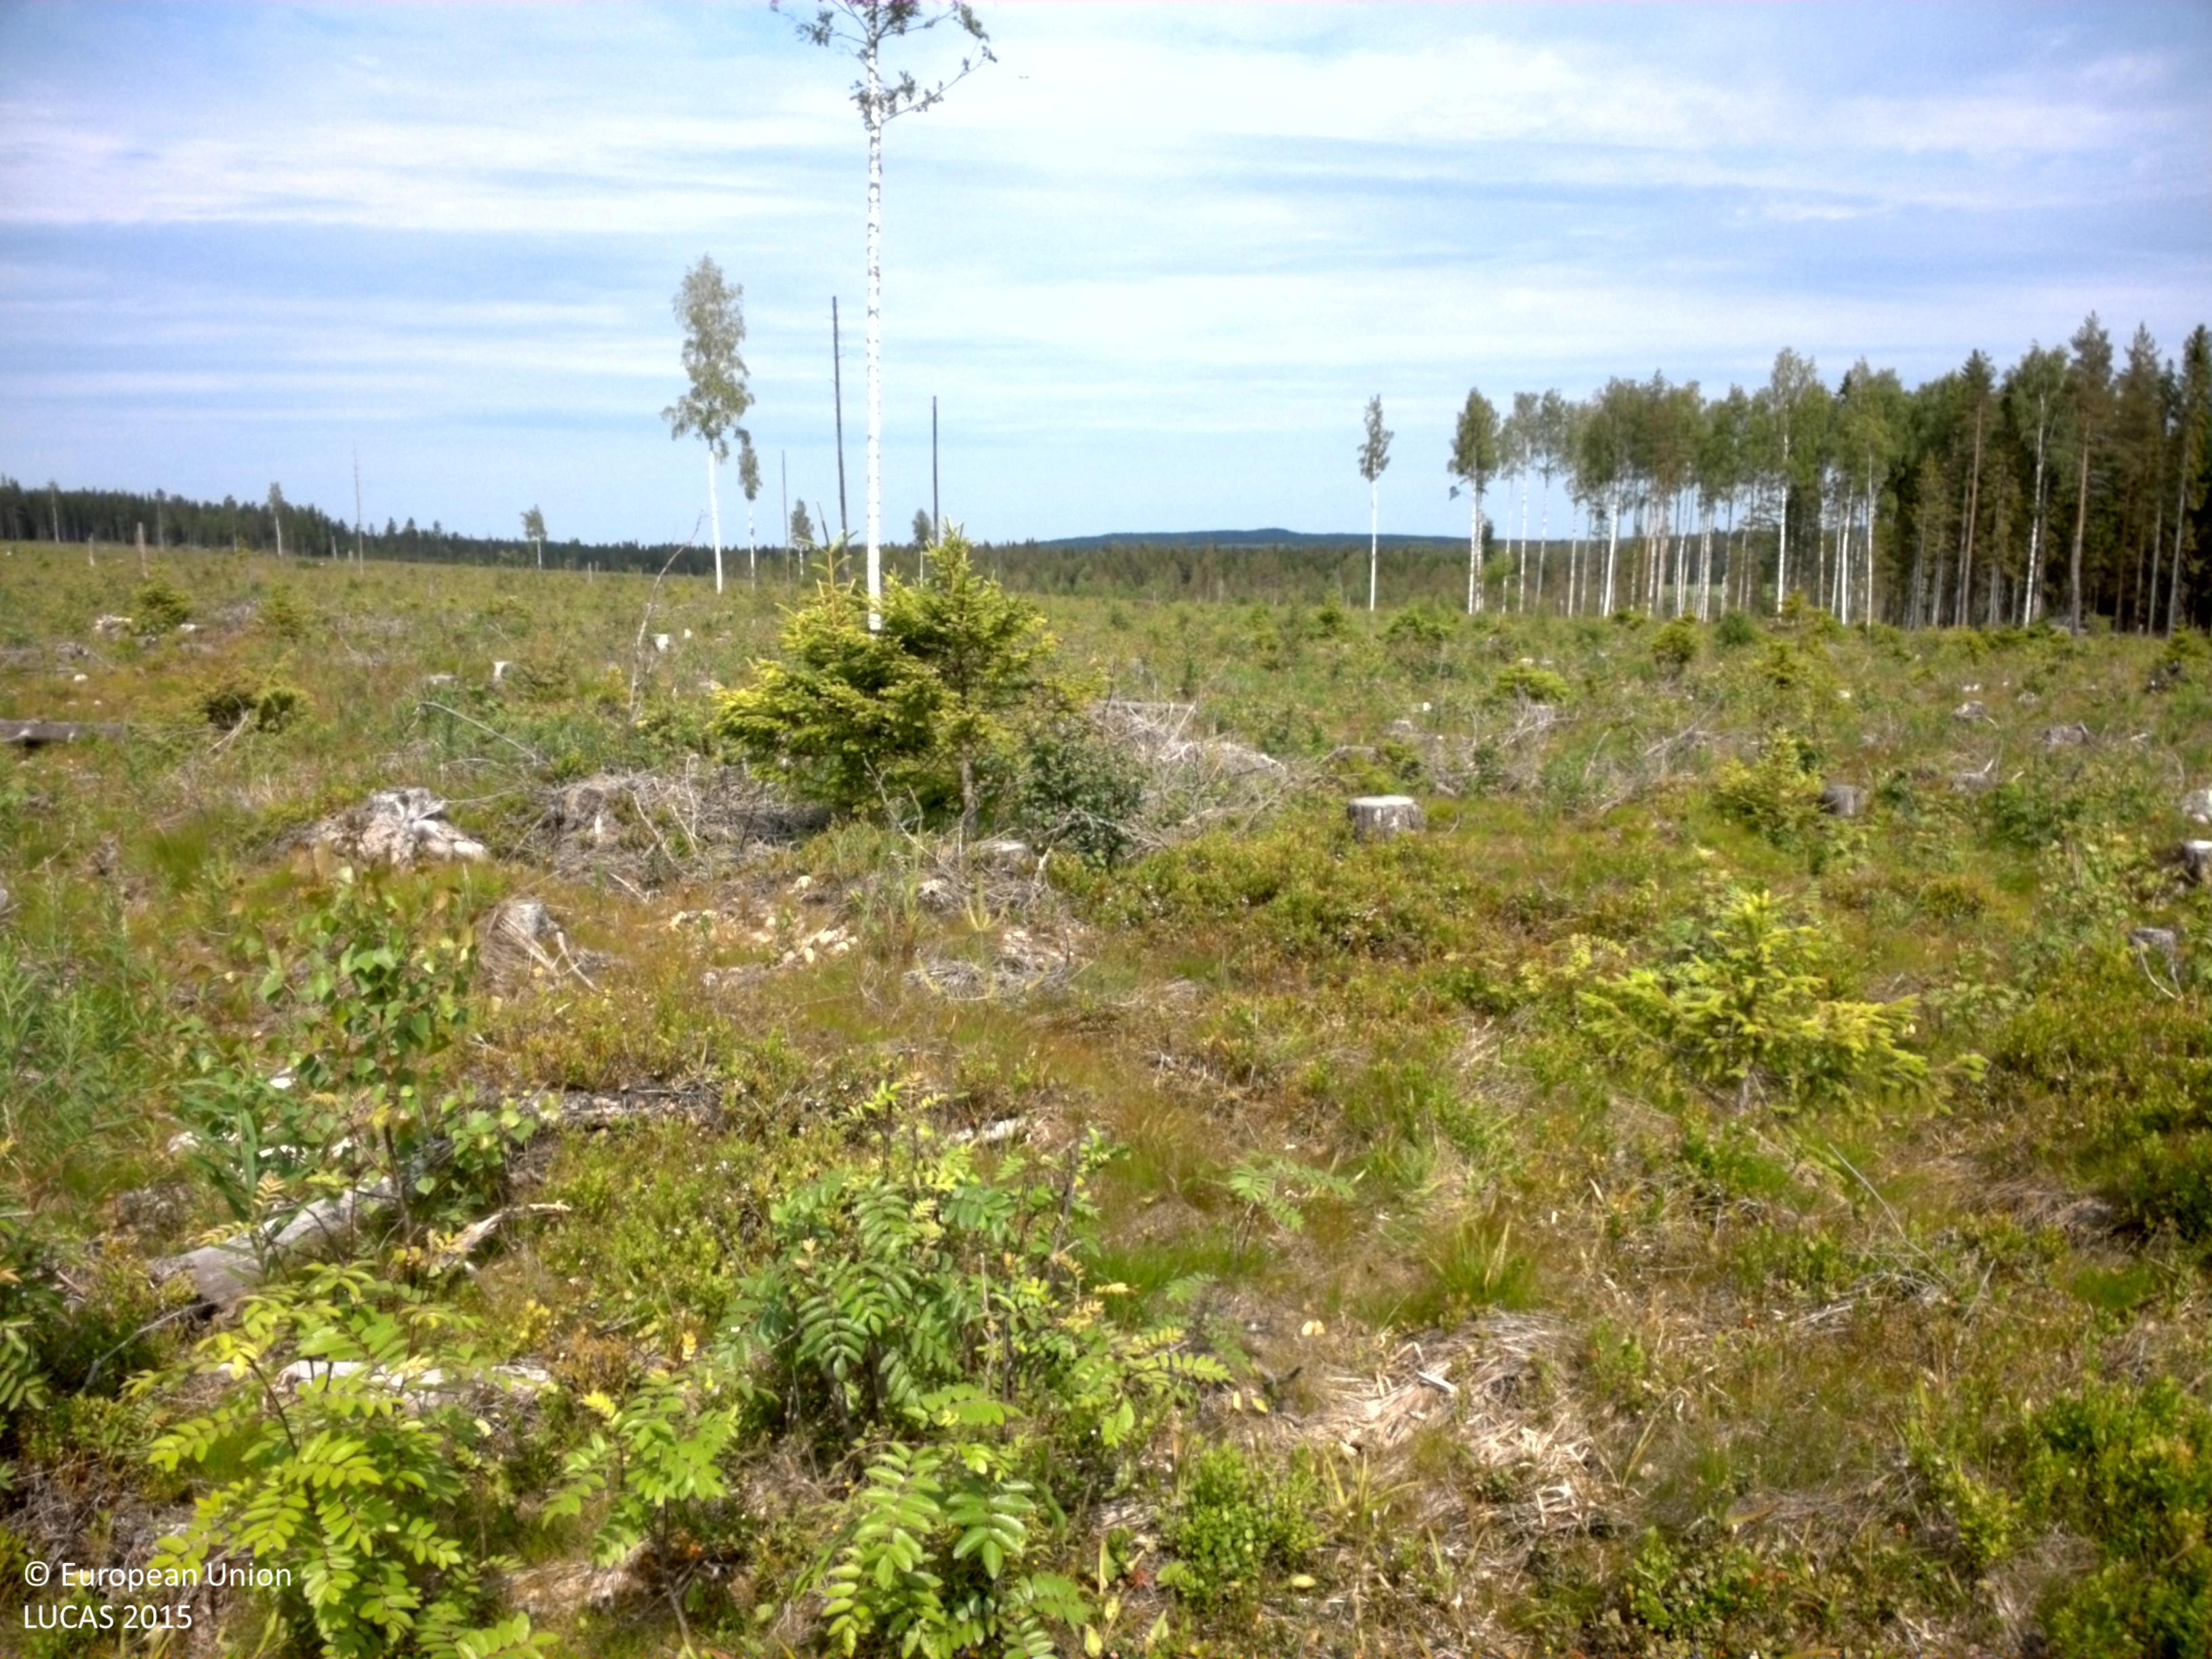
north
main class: Grassland
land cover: Grassland with sparse tree/shrub cover
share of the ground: > 75 %
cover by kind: herbaceous plants 75 %, shrubs 10 %, unconsolidated bare surface 10 %, broadleaved forest trees 5 %
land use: Forestry
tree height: > 5 m
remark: Clear cut
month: July
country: SE
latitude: 64.4400
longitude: 20.9283
